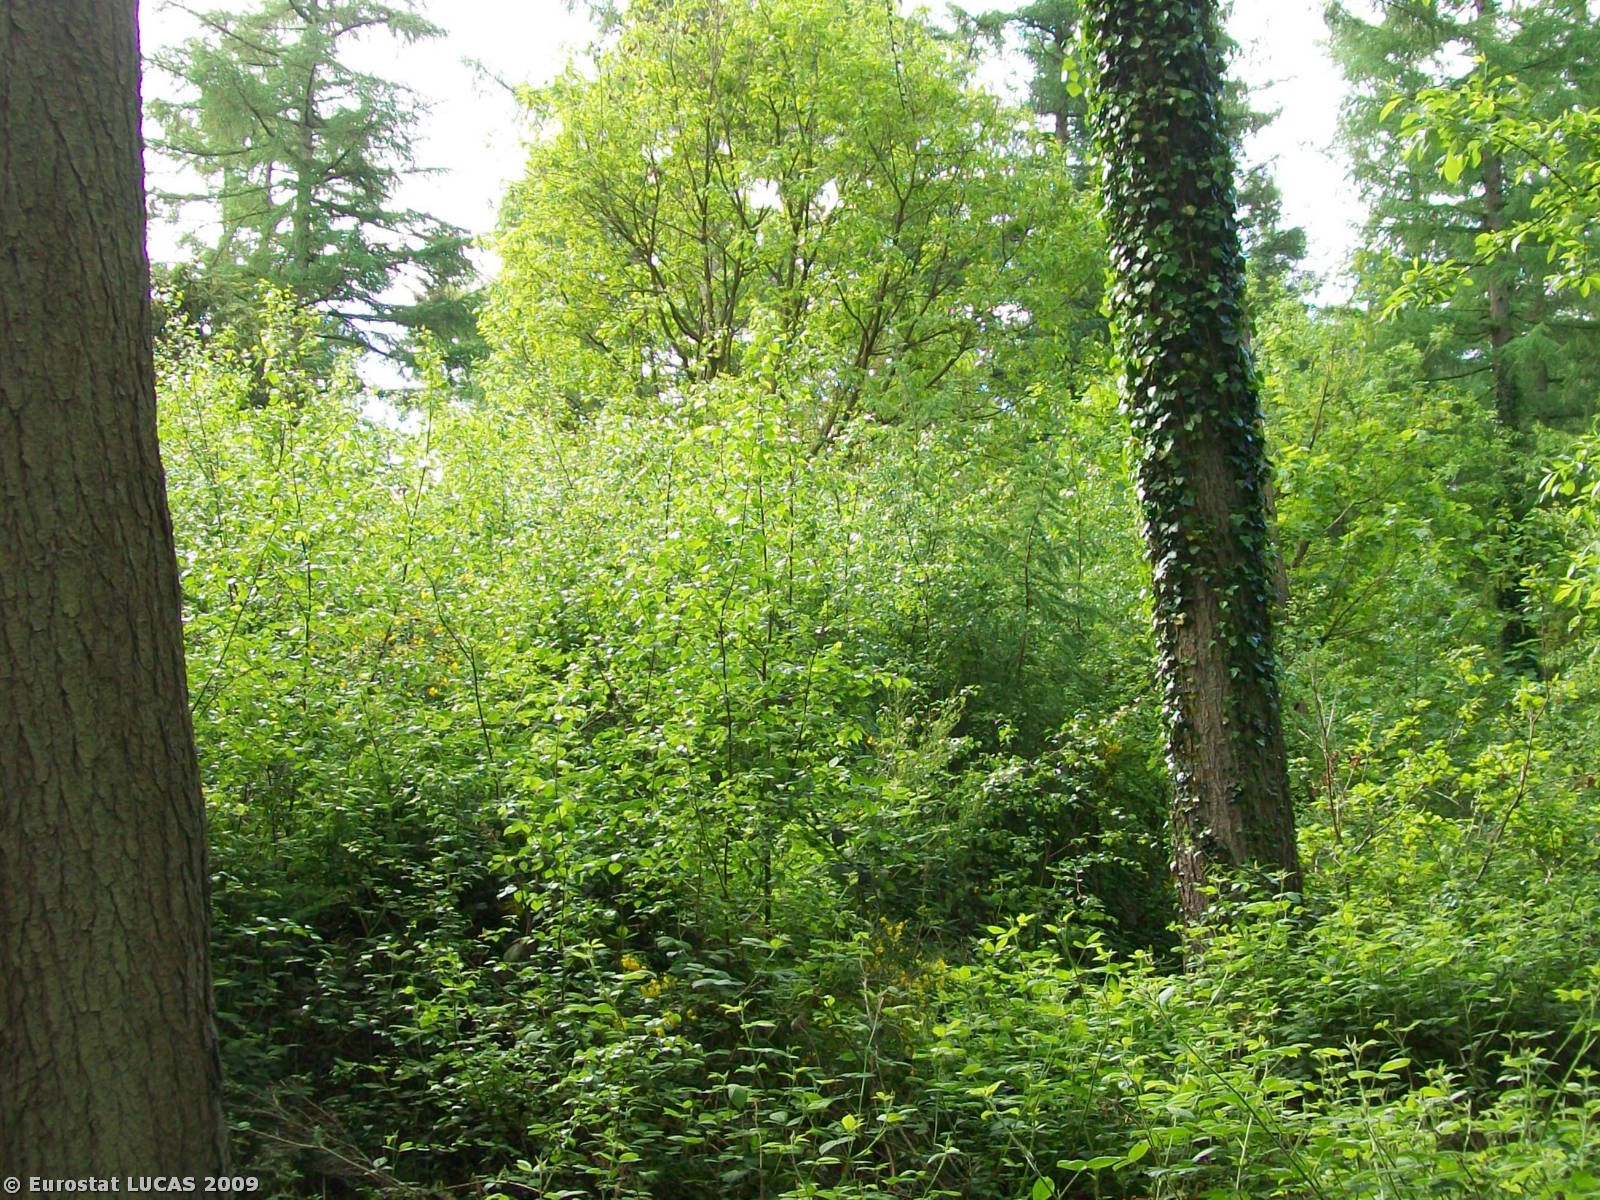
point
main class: Woodland
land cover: Coniferous woodland
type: plantations and self-sown exotic forest
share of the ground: 50 - 75 %
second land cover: Spontaneously vegetated surfaces
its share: > 75 %
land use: Community services
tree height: > 5 m
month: May
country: GB
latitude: 51.1837
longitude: -2.1787
